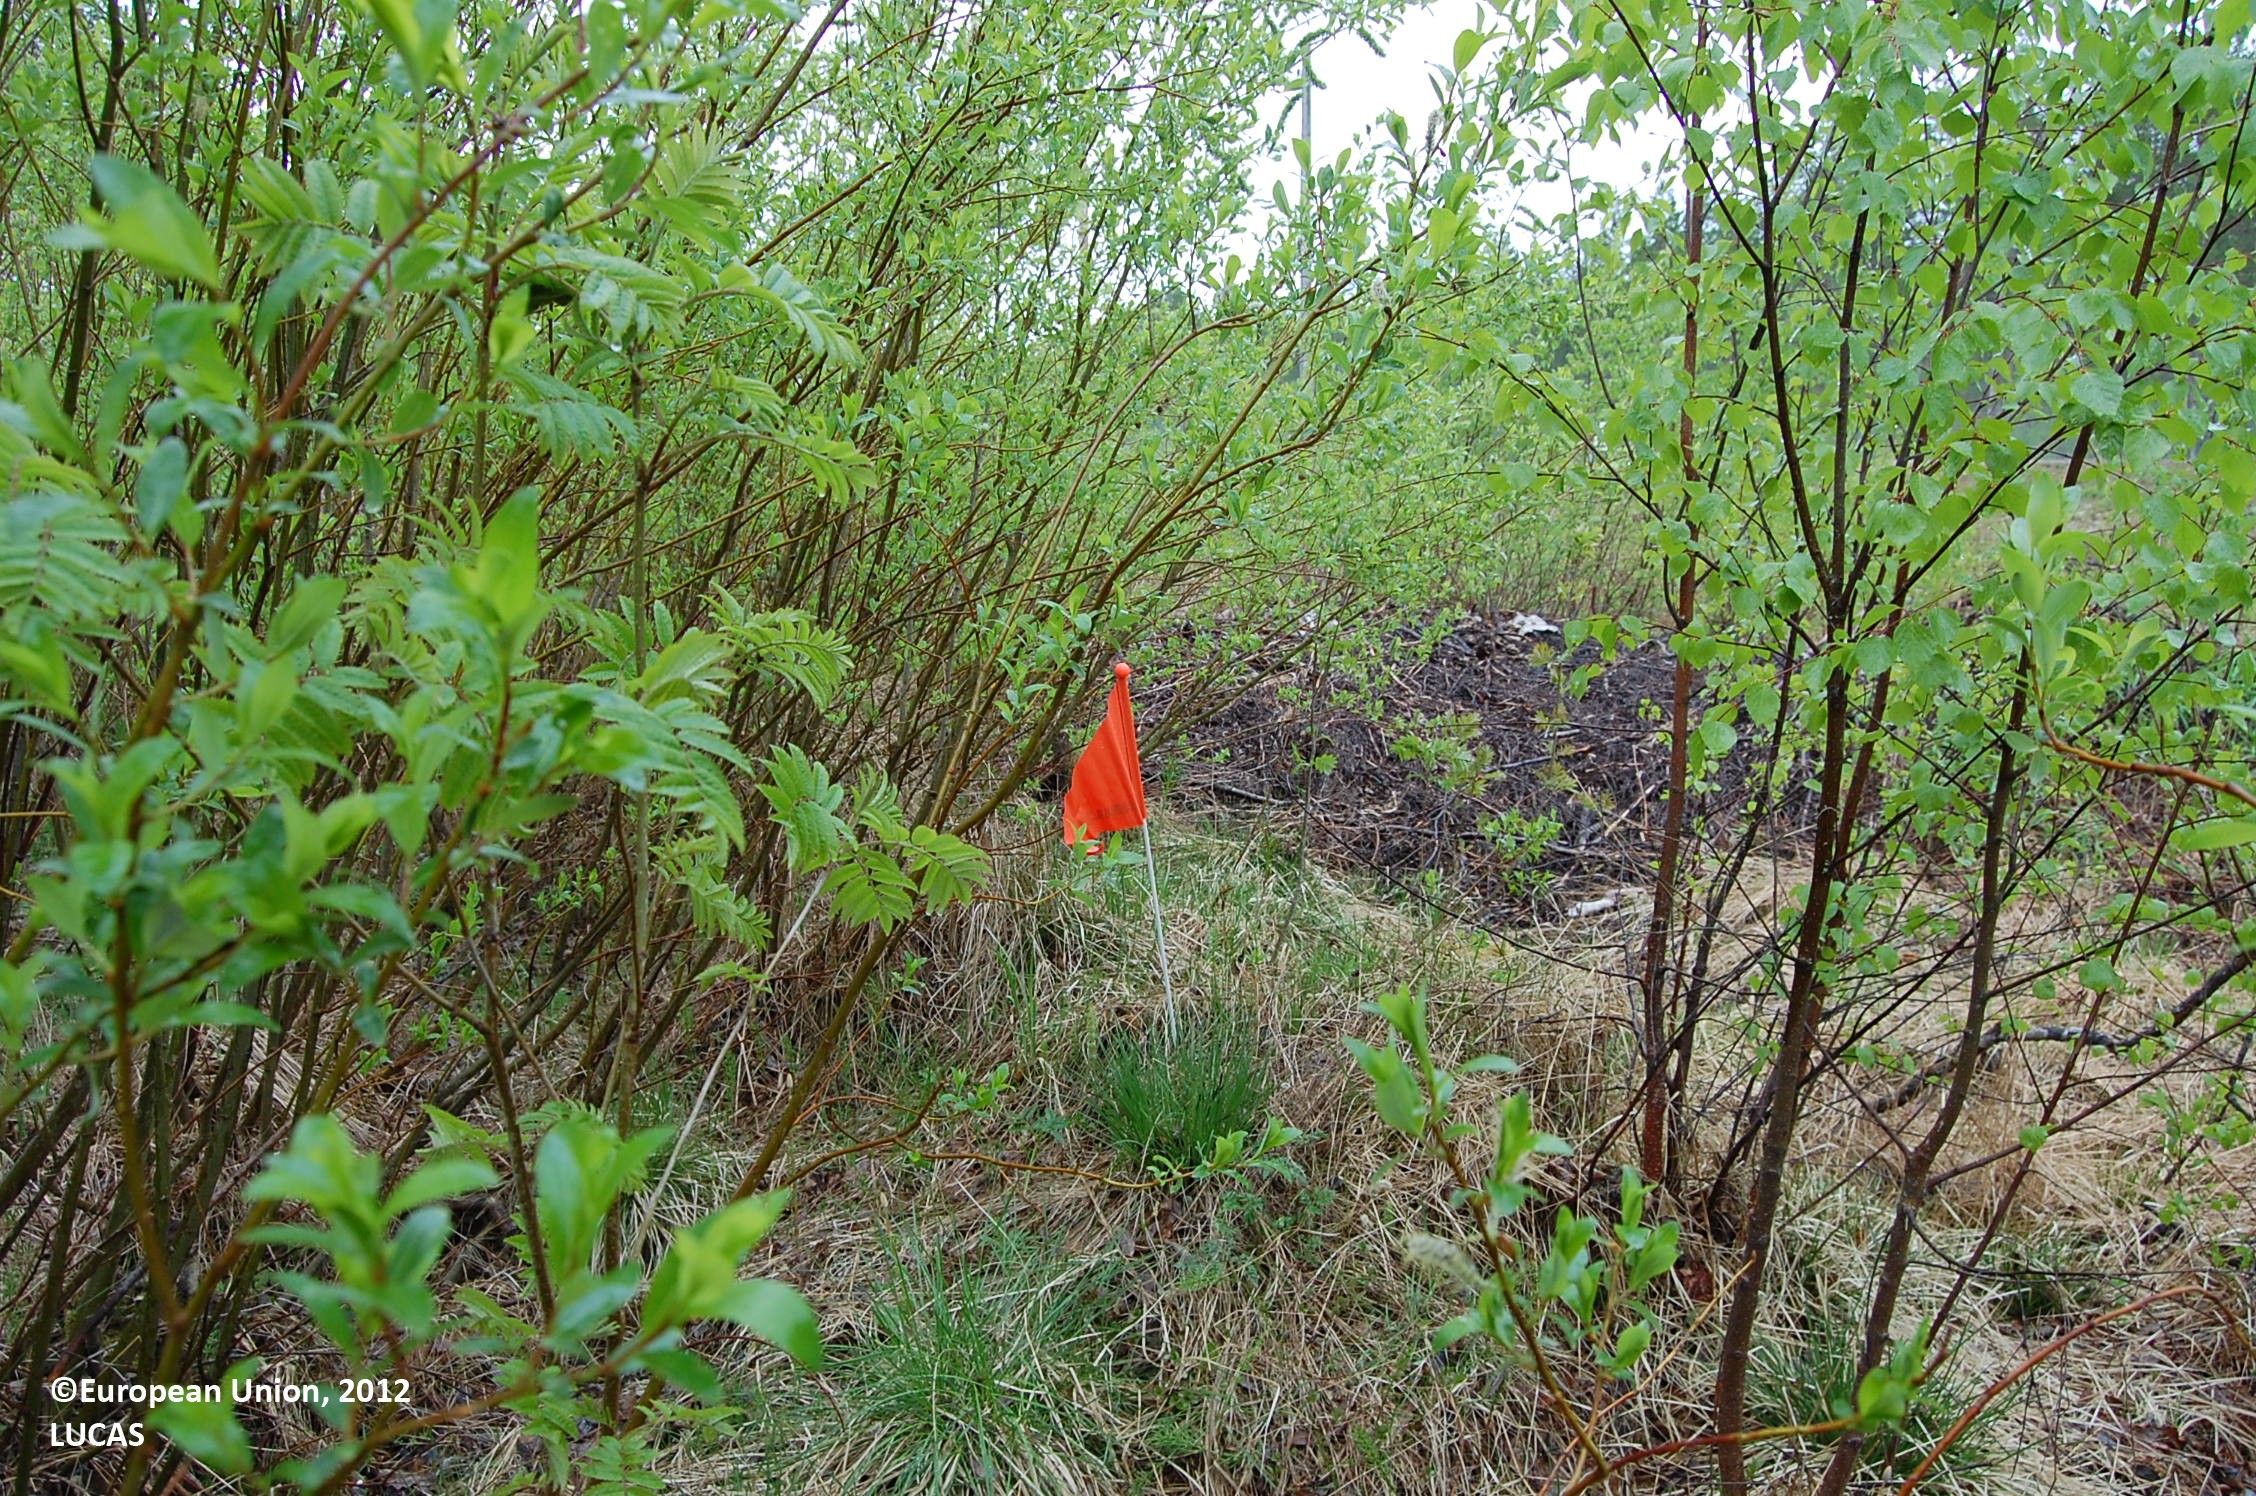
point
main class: Shrubland
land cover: Shrubland without tree cover
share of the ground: > 75 %
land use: Semi-natural and natural areas not in use
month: June
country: FI
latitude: 64.1119
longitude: 27.4094
